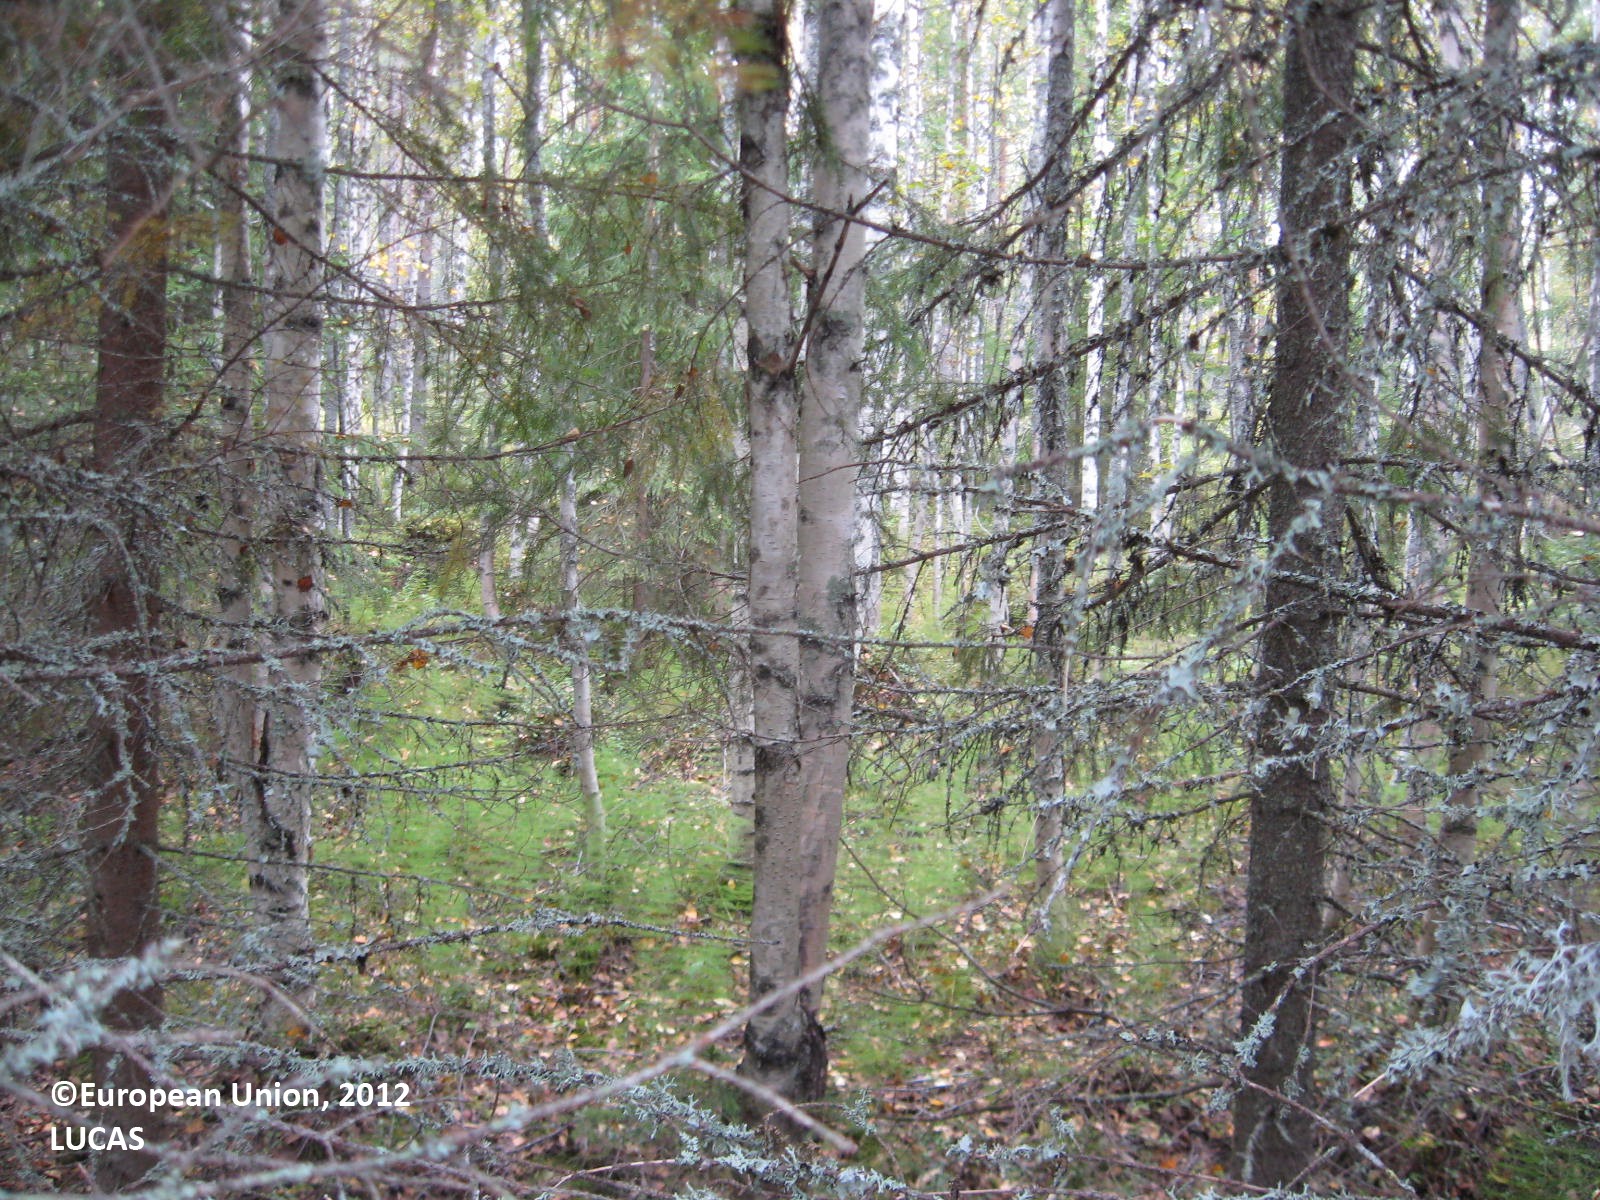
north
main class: Woodland
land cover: Other mixed woodland
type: boreal forest
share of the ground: > 75 %
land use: Forestry
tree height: > 5 m
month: August
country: FI
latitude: 63.8894
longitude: 29.1268
